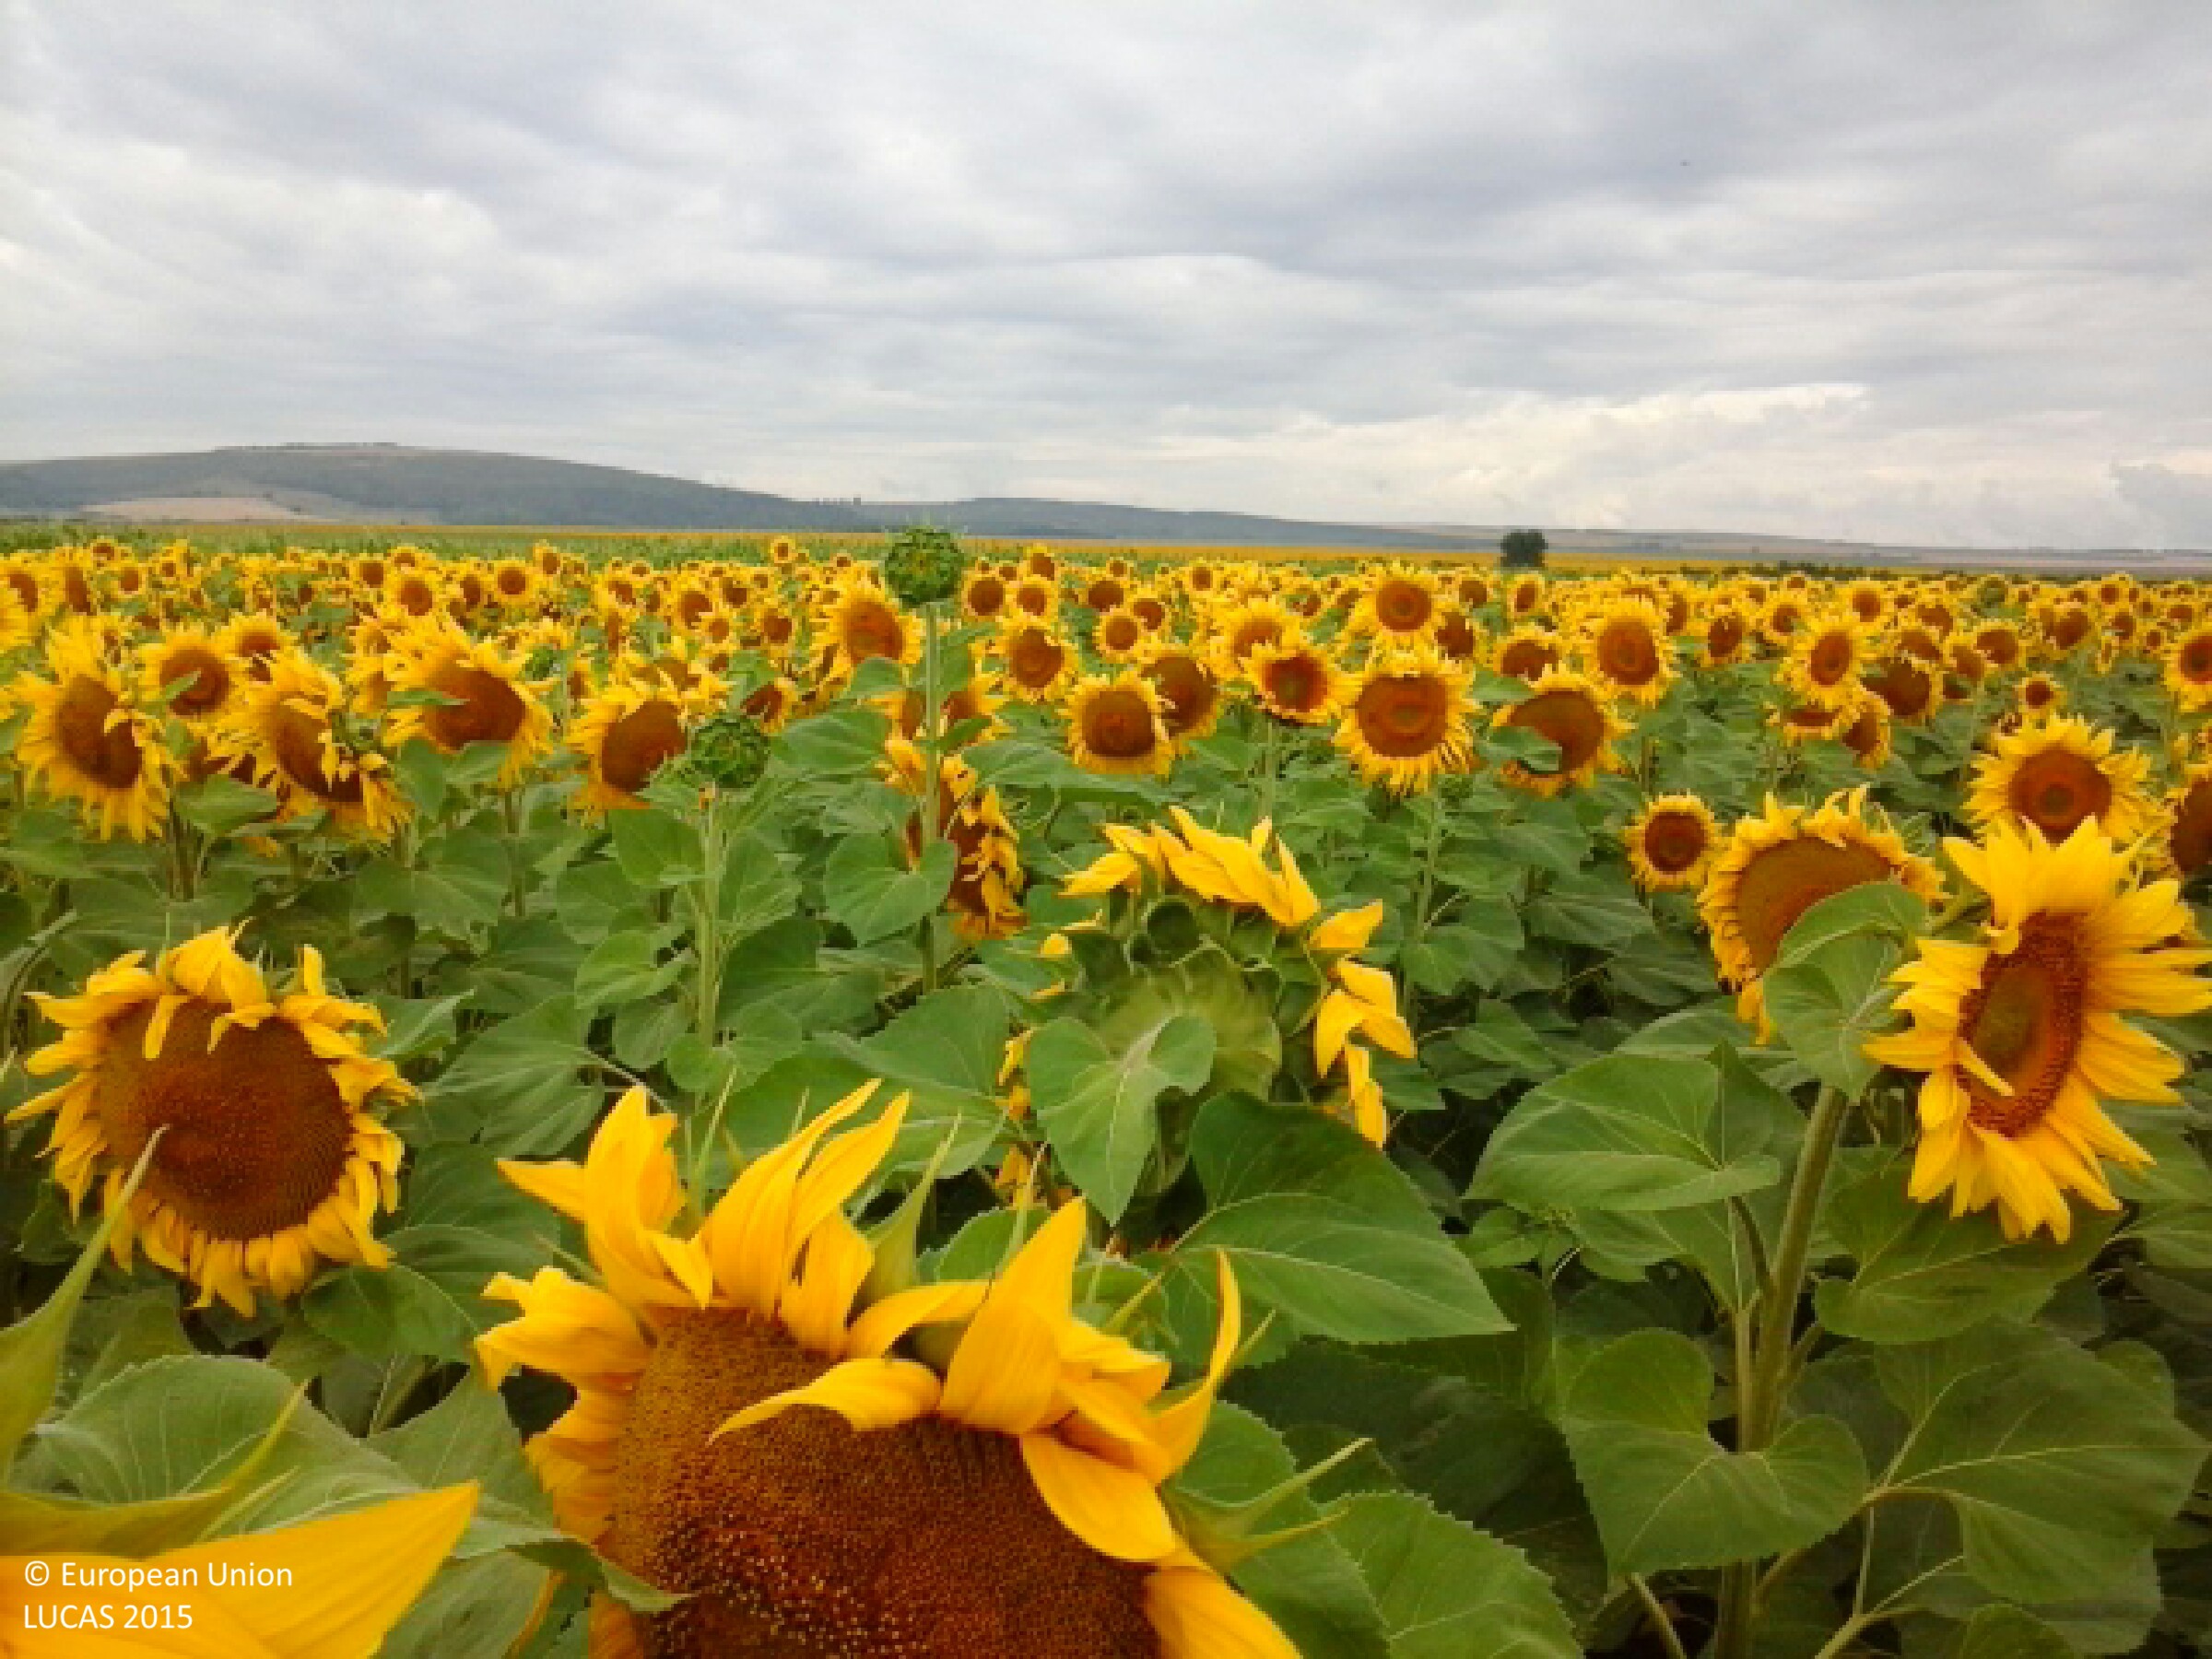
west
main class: Cropland
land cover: Sunflower
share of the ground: > 75 %
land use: Agriculture (excluding fallow land and kitchen gardens)
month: July
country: HU
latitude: 48.2195
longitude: 21.1457
